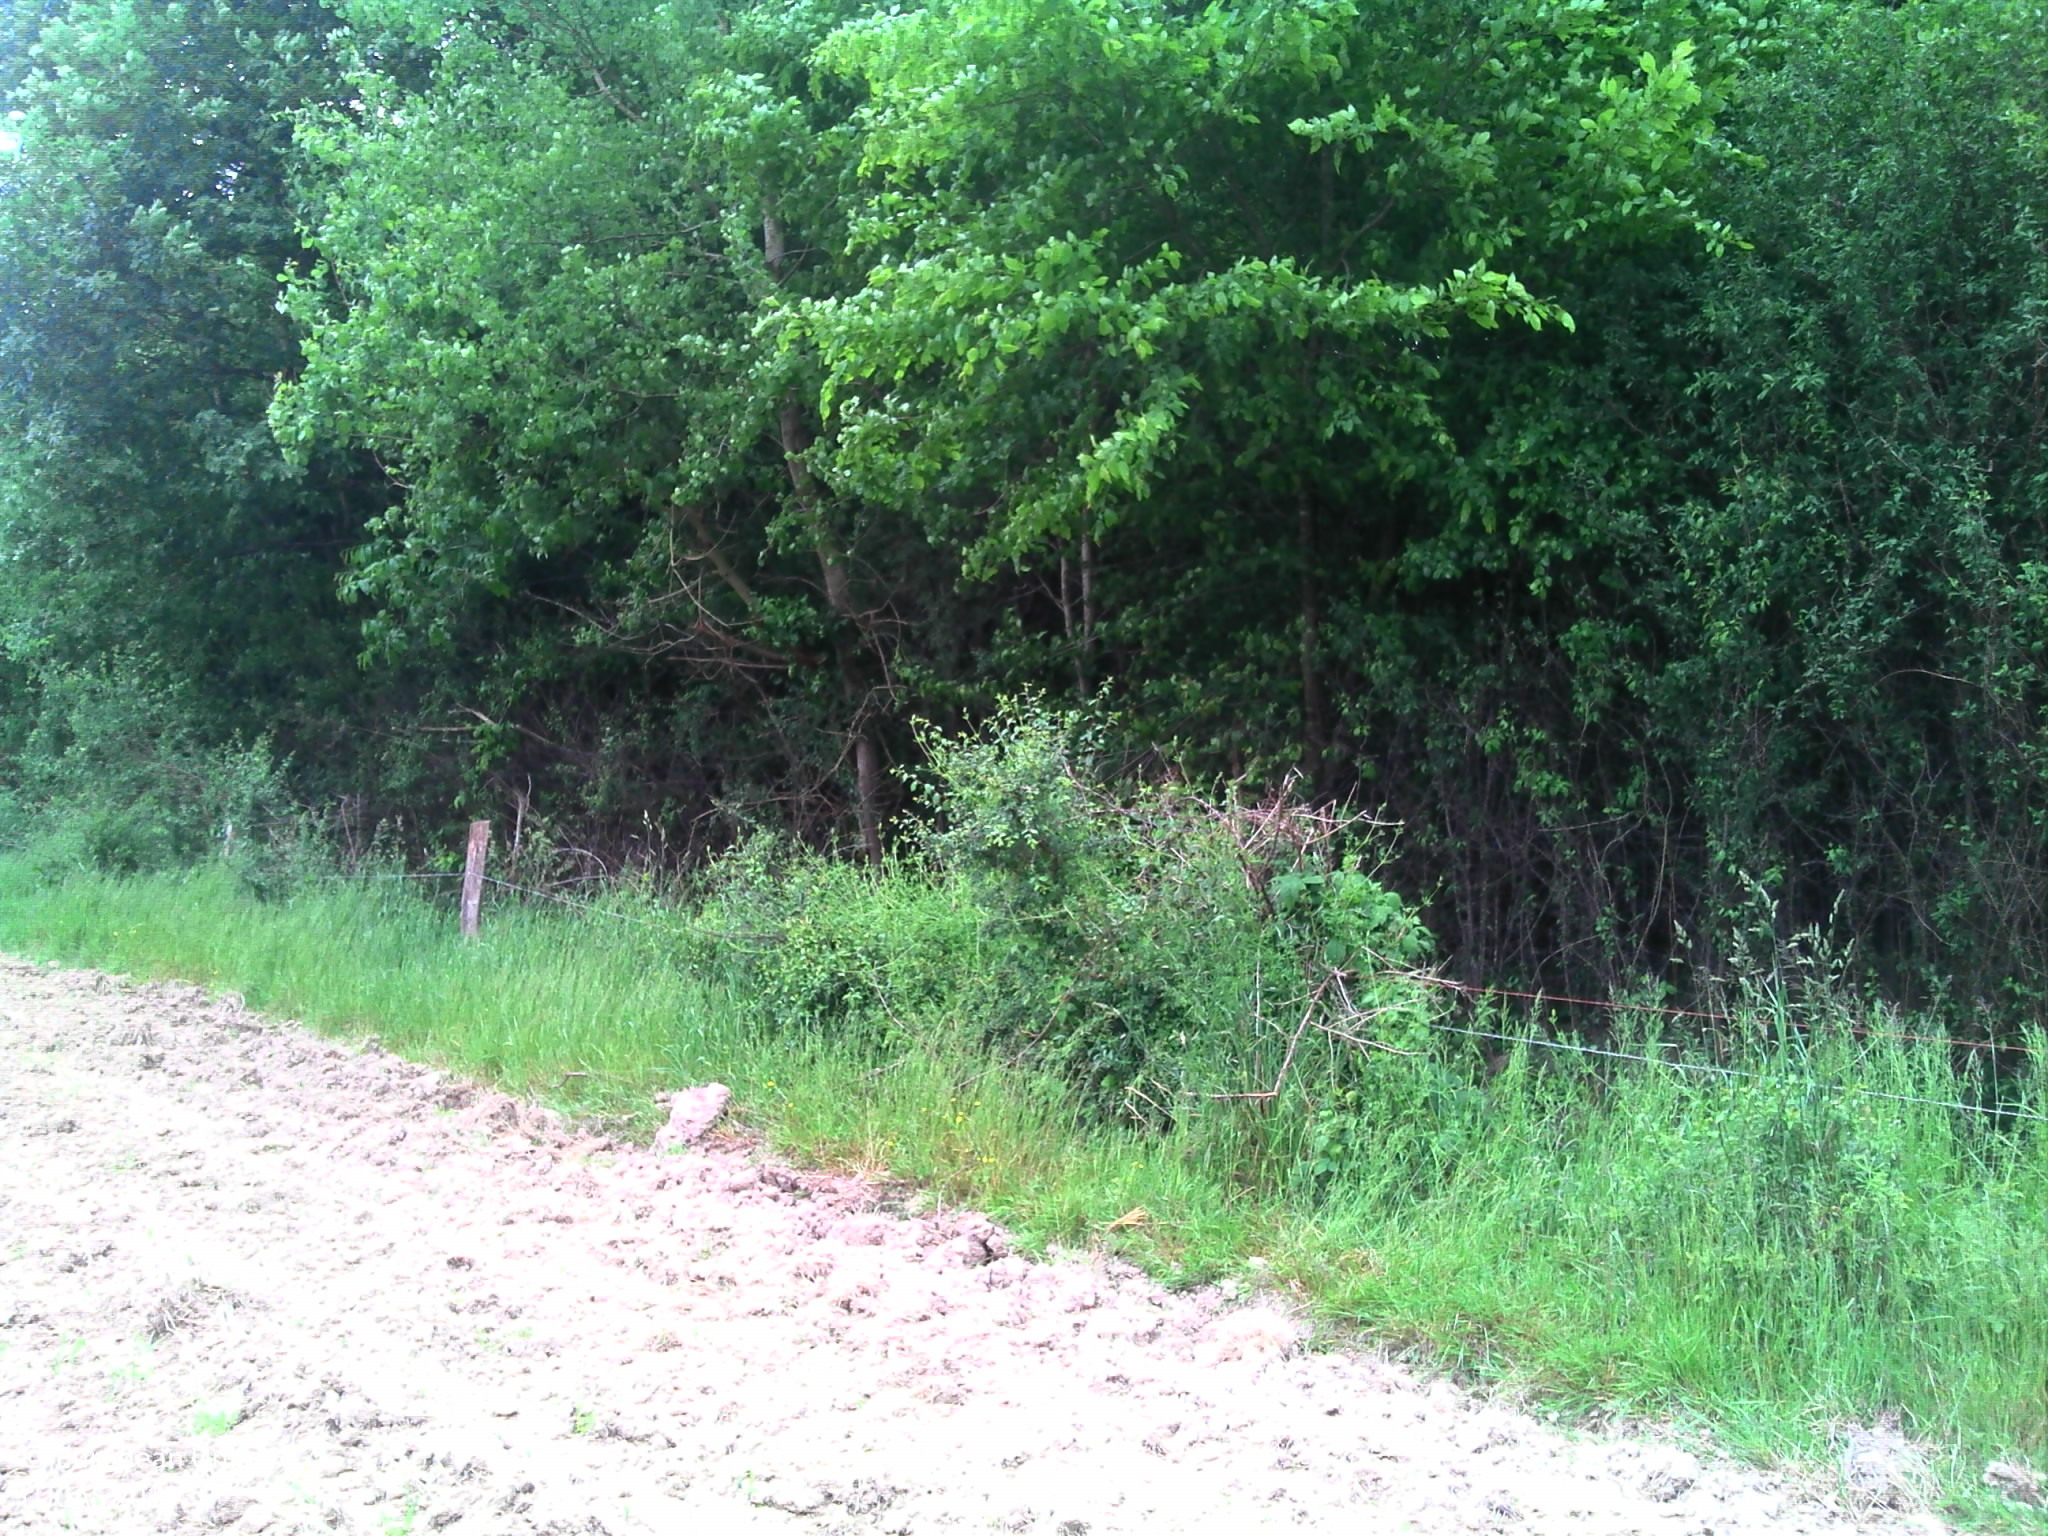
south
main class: Woodland
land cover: Broadleaved woodland
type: mesophytic deciduous forest
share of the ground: > 75 %
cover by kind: broadleaved forest trees 90 %, herbaceous plants 5 %, lichens and mosses 5 %
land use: Forestry
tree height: > 5 m
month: May
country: FR
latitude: 47.6353
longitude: 0.7568
